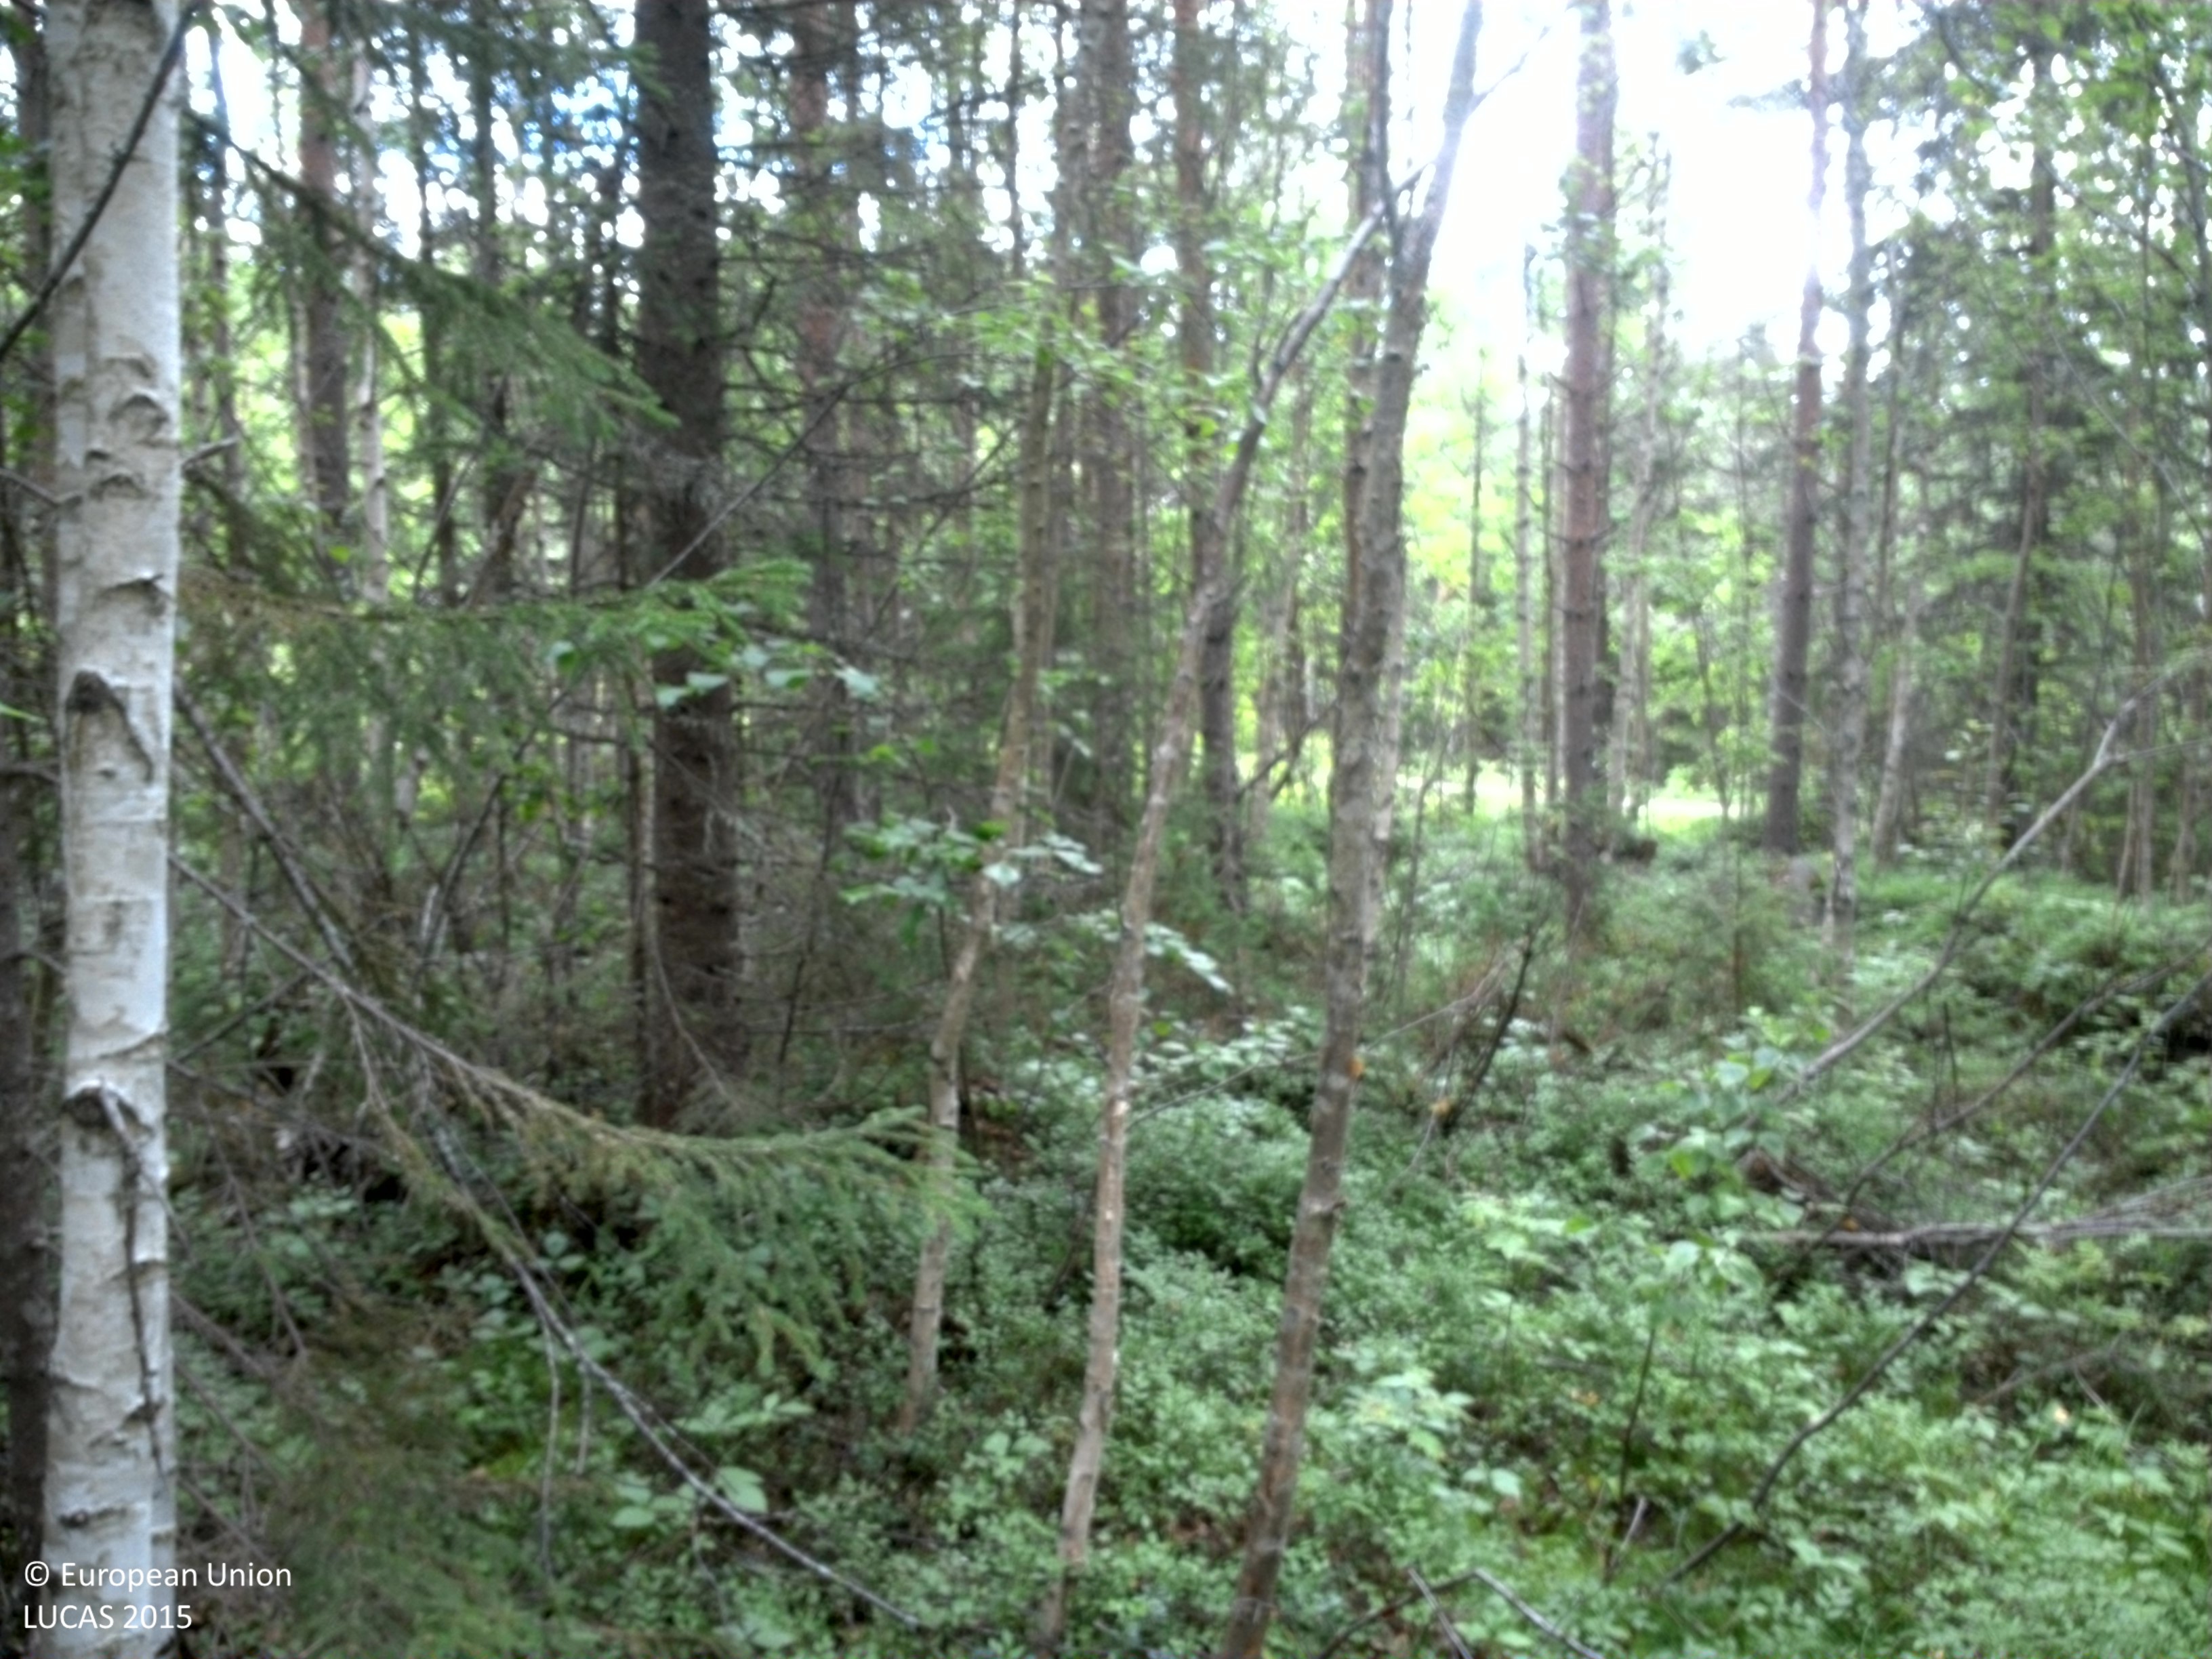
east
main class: Woodland
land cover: Spruce dominated mixed woodland
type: boreal forest
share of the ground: > 75 %
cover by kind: coniferous forest trees 60 %, broadleaved forest trees 20 %, shrubs 10 %, herbaceous plants 5 %, lichens and mosses 5 %
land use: Forestry
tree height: > 5 m
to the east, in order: Spruce dominated mixed woodland; Broadleaved woodland; Grass margins; Paved roads, cycling and walking lanes; Grass margins; Broadleaved woodland; Other coniferous woodland; Pine dominated coniferous woodland
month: August
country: SE
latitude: 64.6619
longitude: 20.8894
